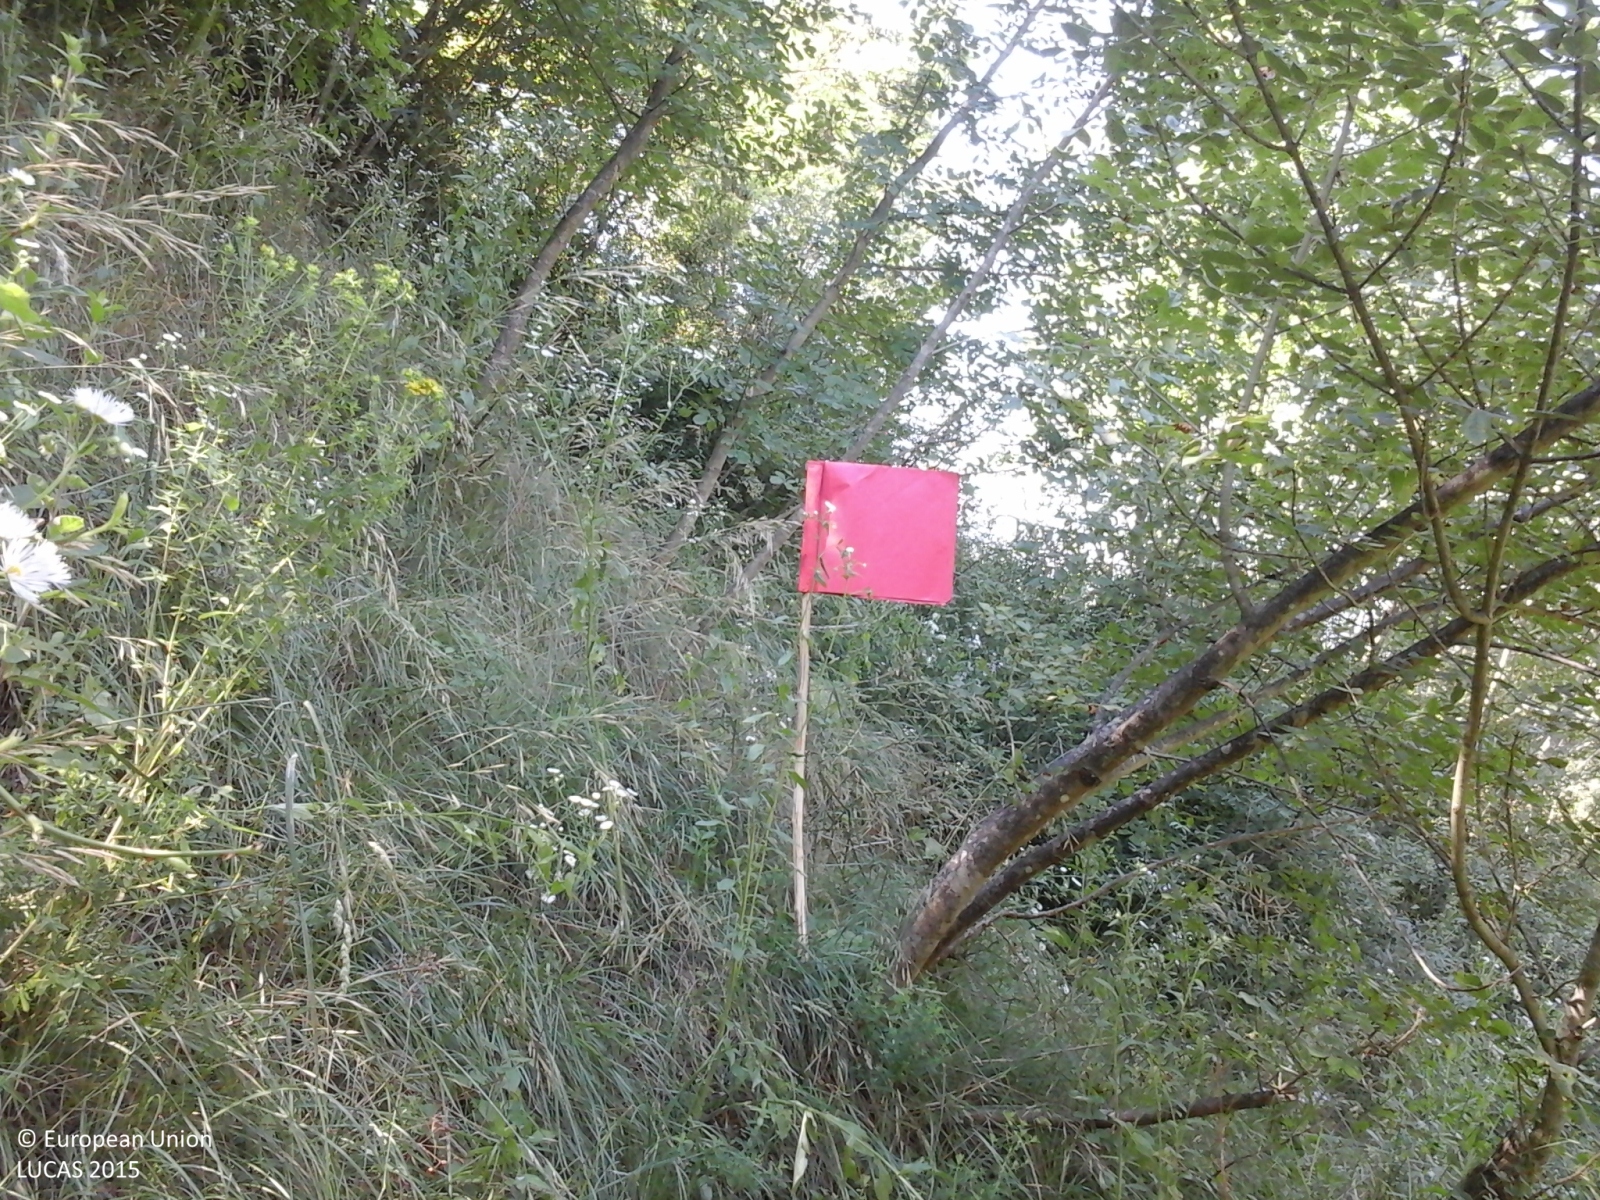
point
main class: Woodland
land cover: Broadleaved woodland
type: thermophilous deciduous forest
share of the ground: > 75 %
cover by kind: broadleaved forest trees 85 %, herbaceous plants 10 %, shrubs 5 %
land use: Semi-natural and natural areas not in use
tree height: < 5 m
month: June
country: IT
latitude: 44.5175
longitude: 8.3303
